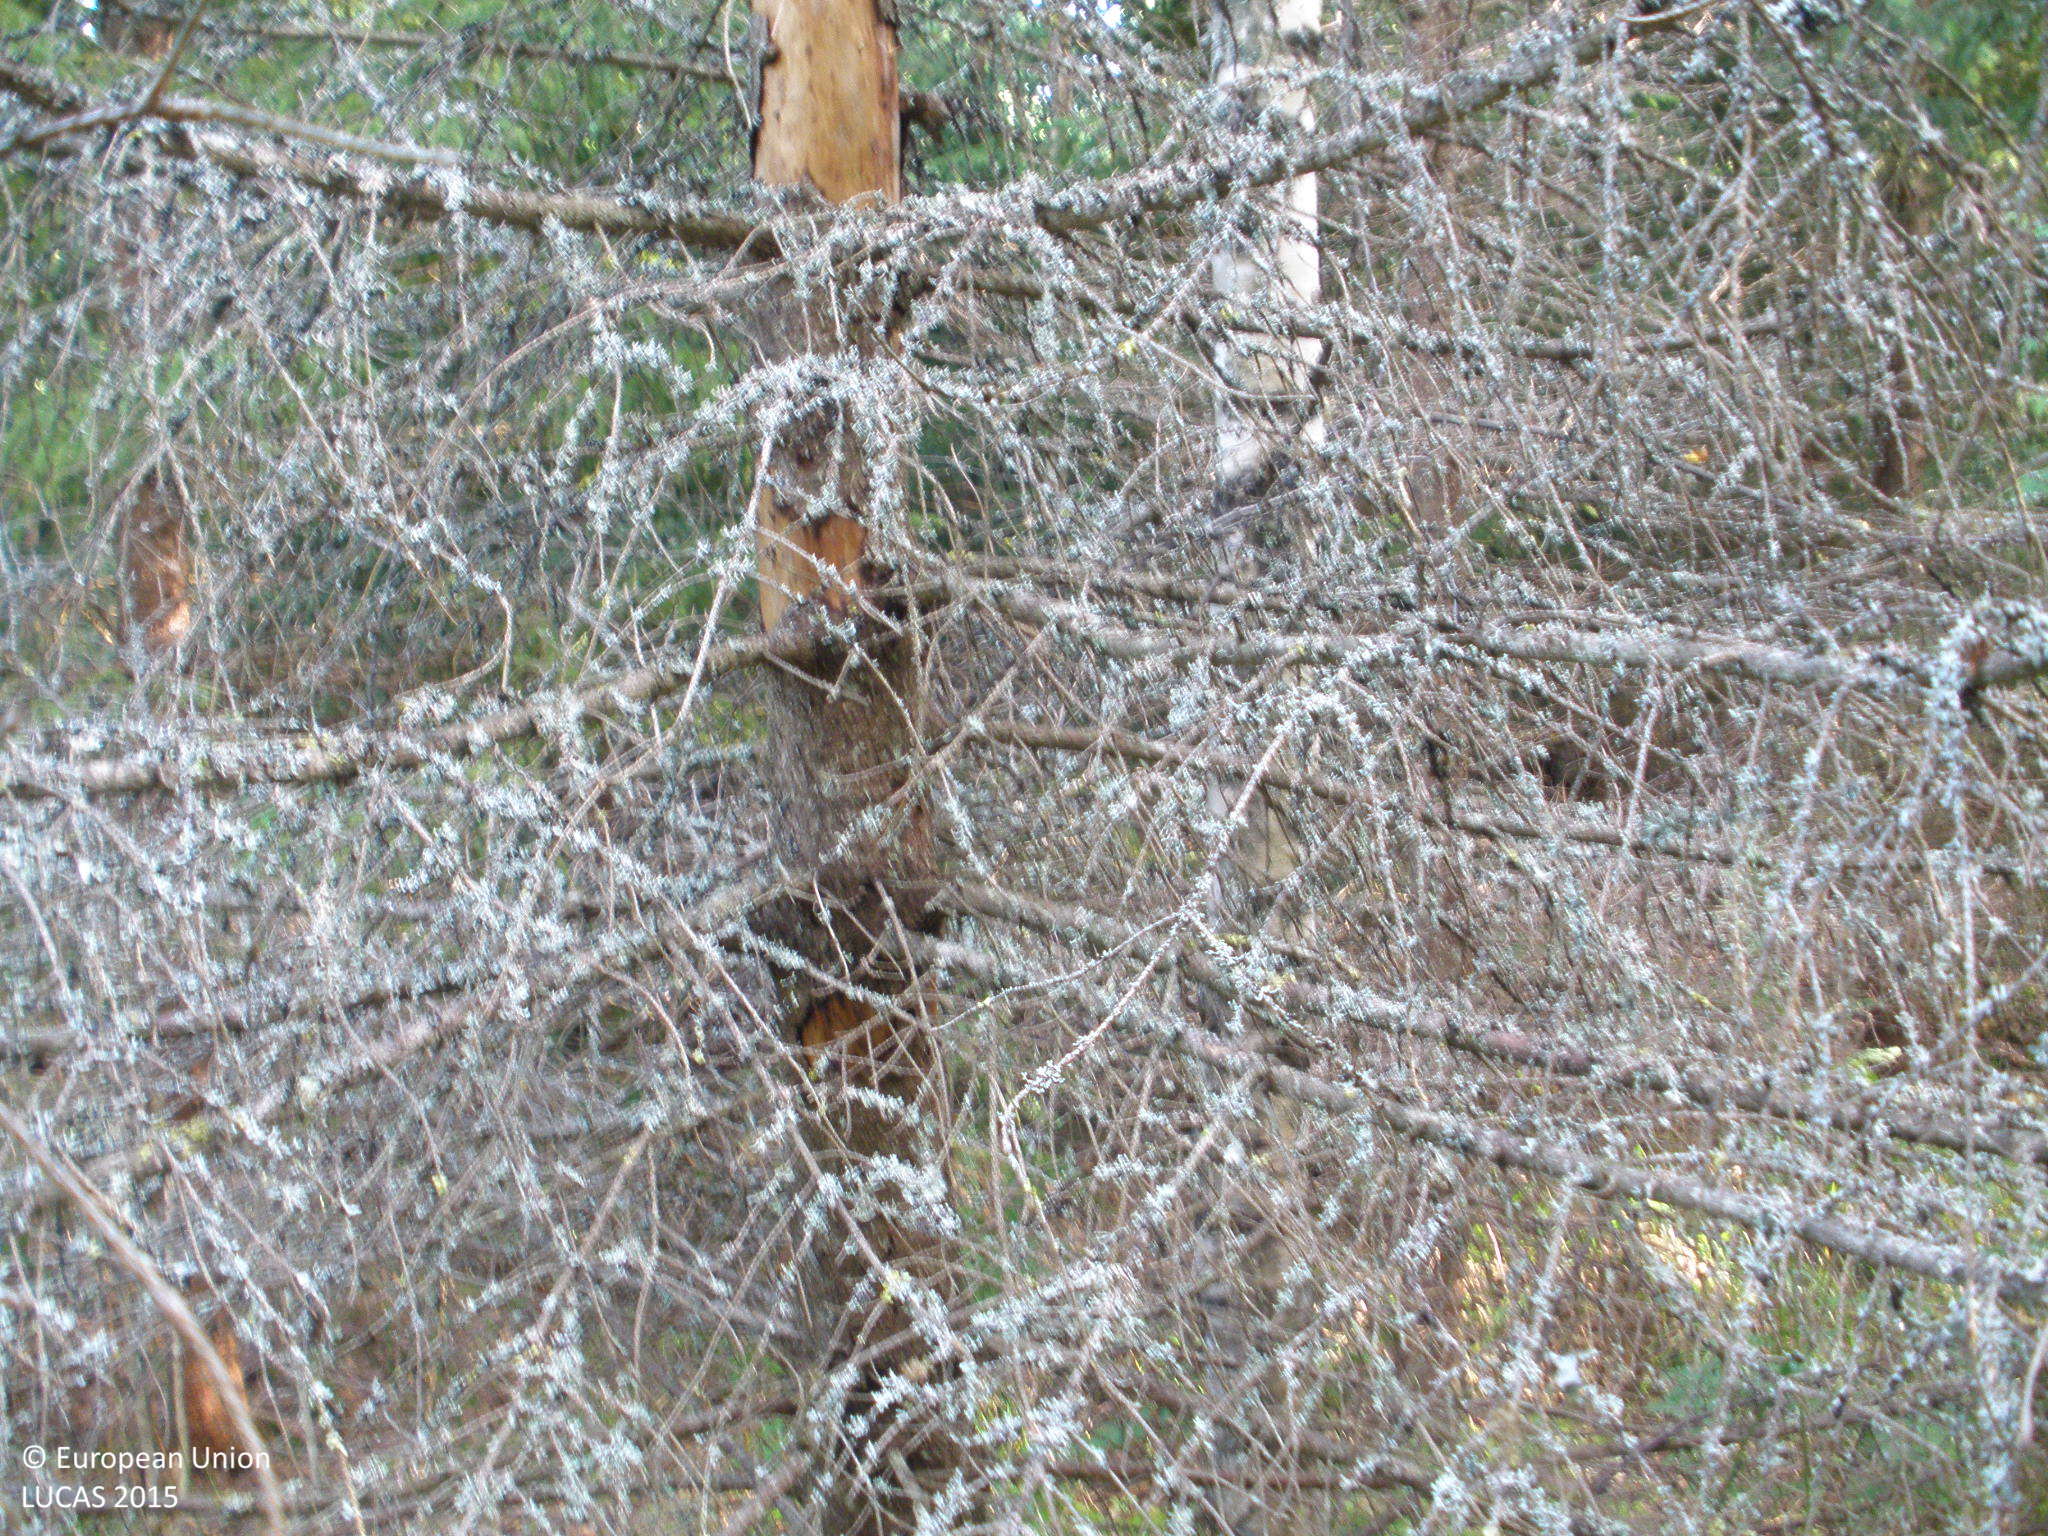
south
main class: Woodland
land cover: Spruce dominated mixed woodland
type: boreal forest
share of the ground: > 75 %
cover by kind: coniferous forest trees 60 %, broadleaved forest trees 25 %, herbaceous plants 10 %, lichens and mosses 5 %
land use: Forestry
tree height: > 5 m
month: August
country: FI
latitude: 60.7050
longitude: 24.3744
